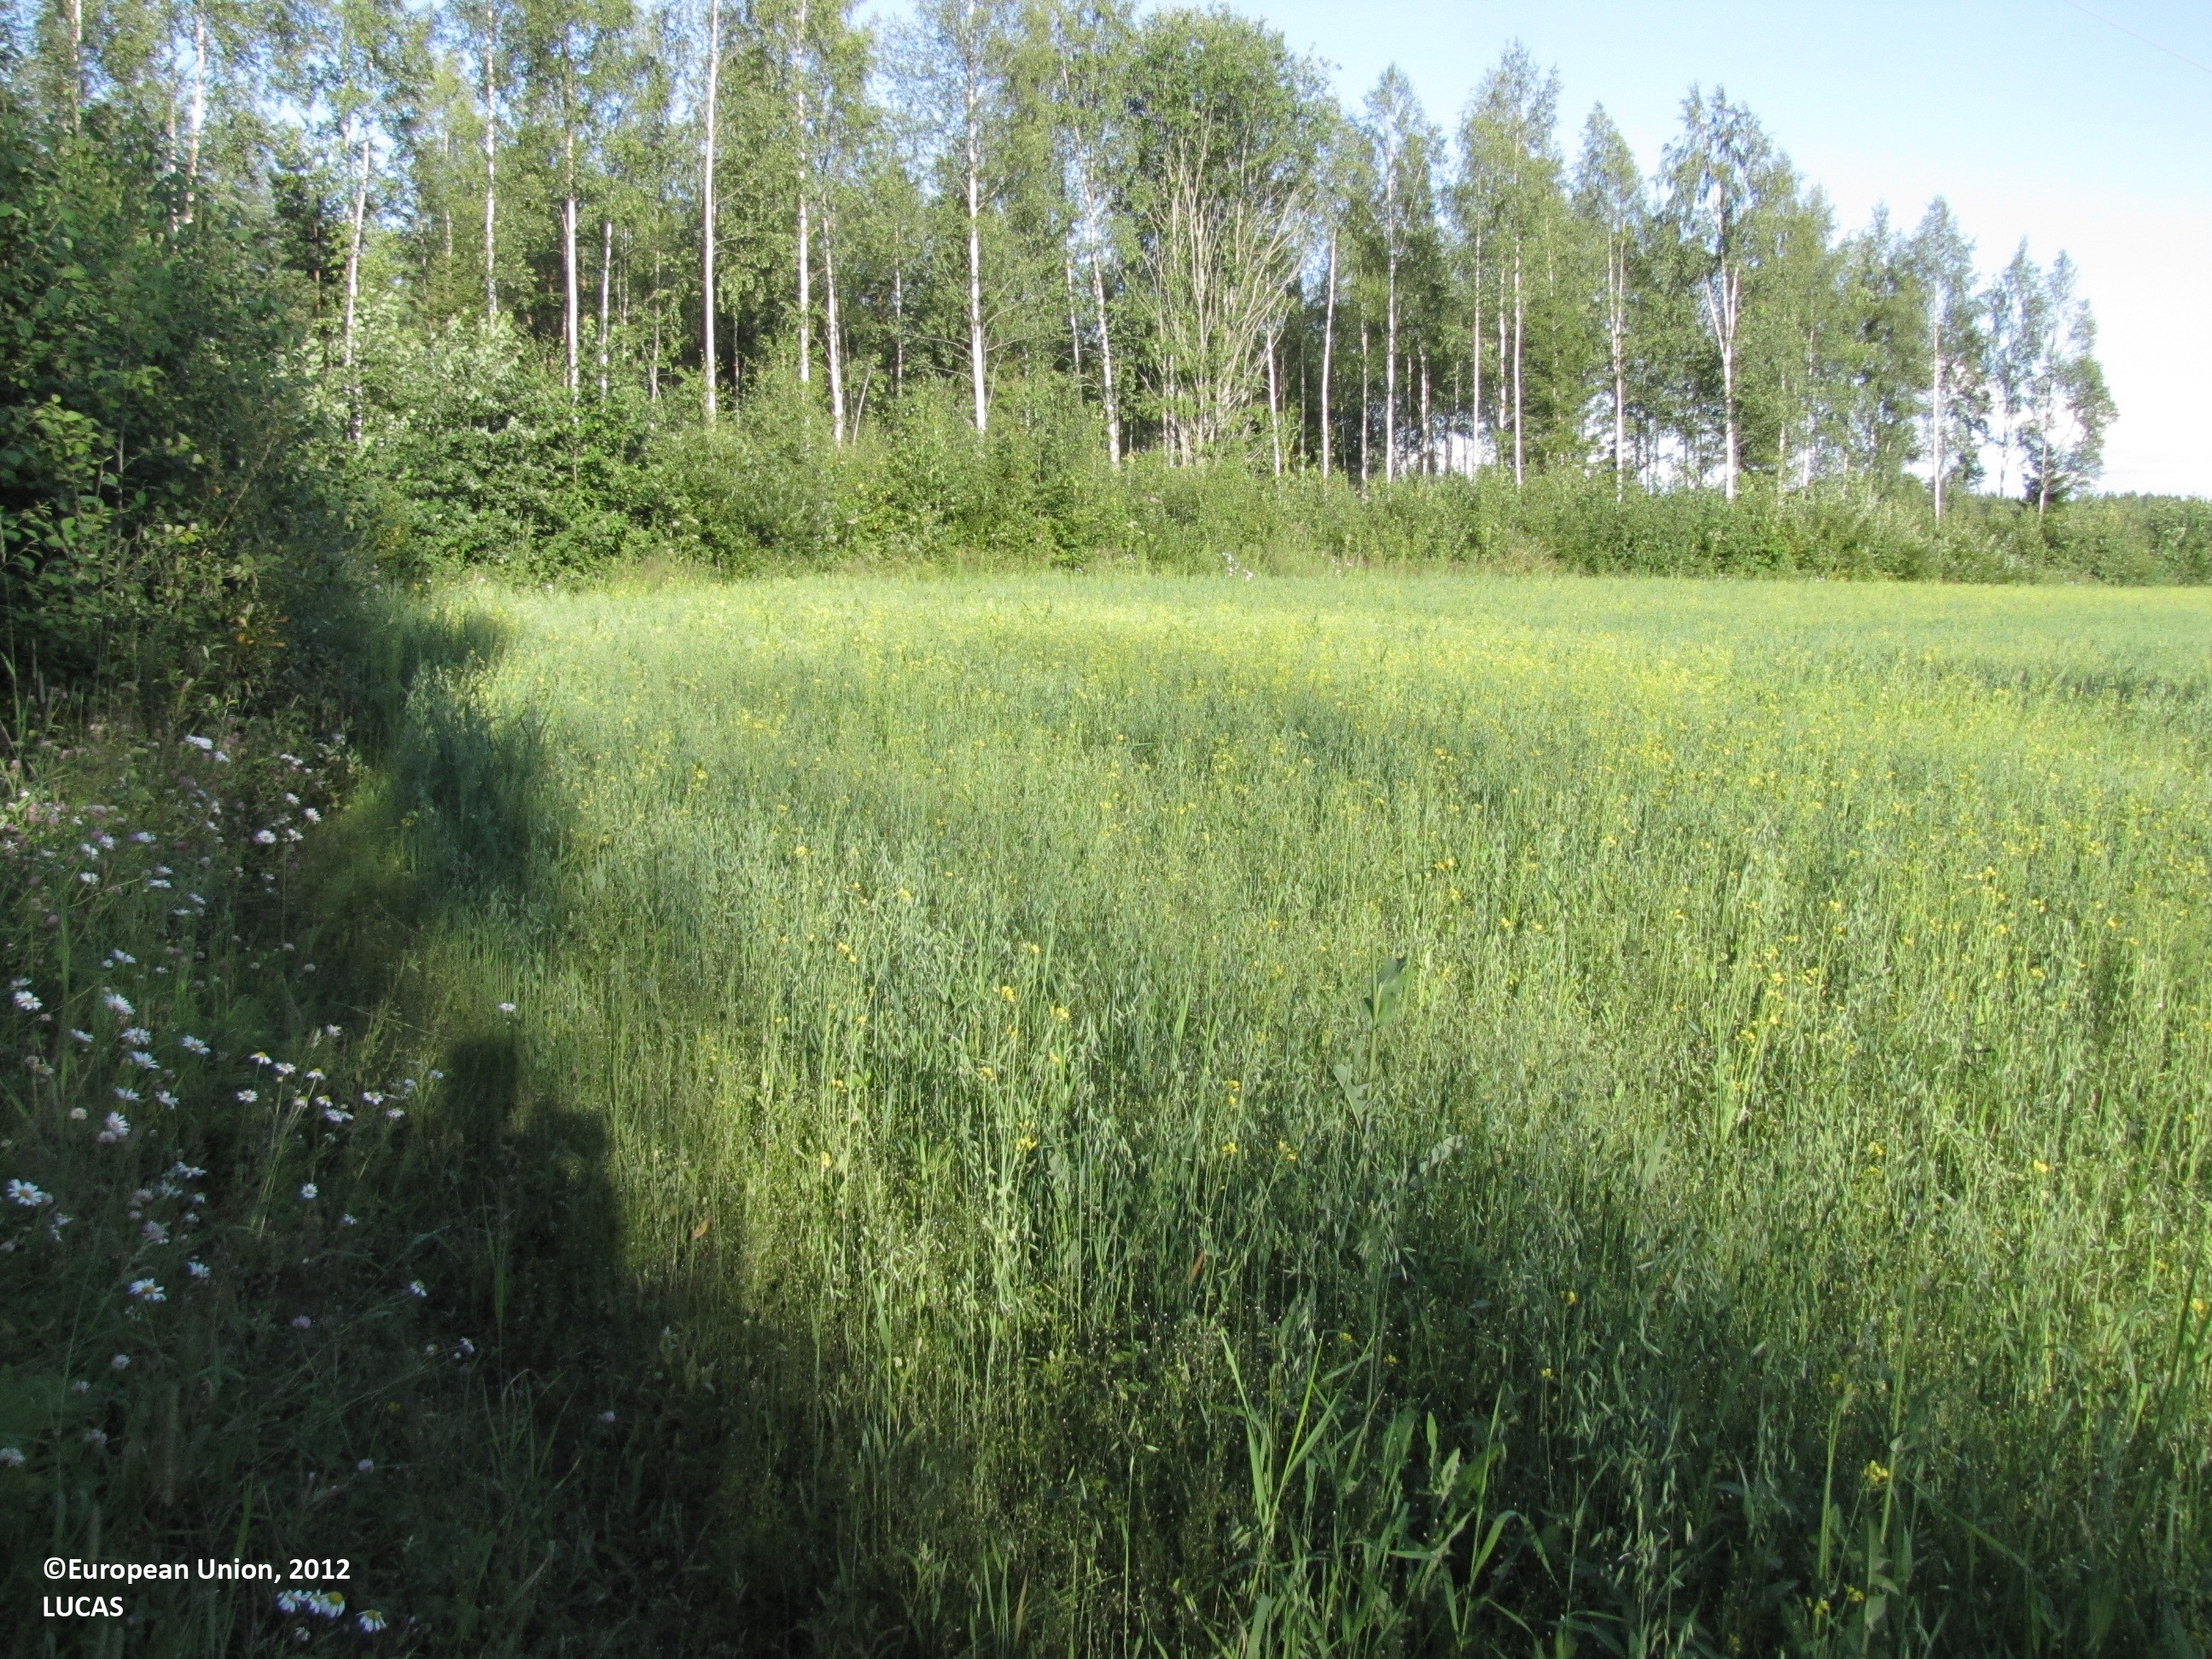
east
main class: Cropland
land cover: Other leguminous and mixtures for fodder
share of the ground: > 75 %
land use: Agriculture (excluding fallow land and kitchen gardens)
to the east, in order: Other leguminous and mixtures for fodder; Electric lines; Other leguminous and mixtures for fodder; Abandoned hedges; Ditches and canals; Broadleaved woodland; Ditches and canals; Abandoned hedges; Other leguminous and mixtures for fodder; Electric lines; Other leguminous and mixtures for fodder
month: July
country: FI
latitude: 62.1153
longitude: 23.0424
